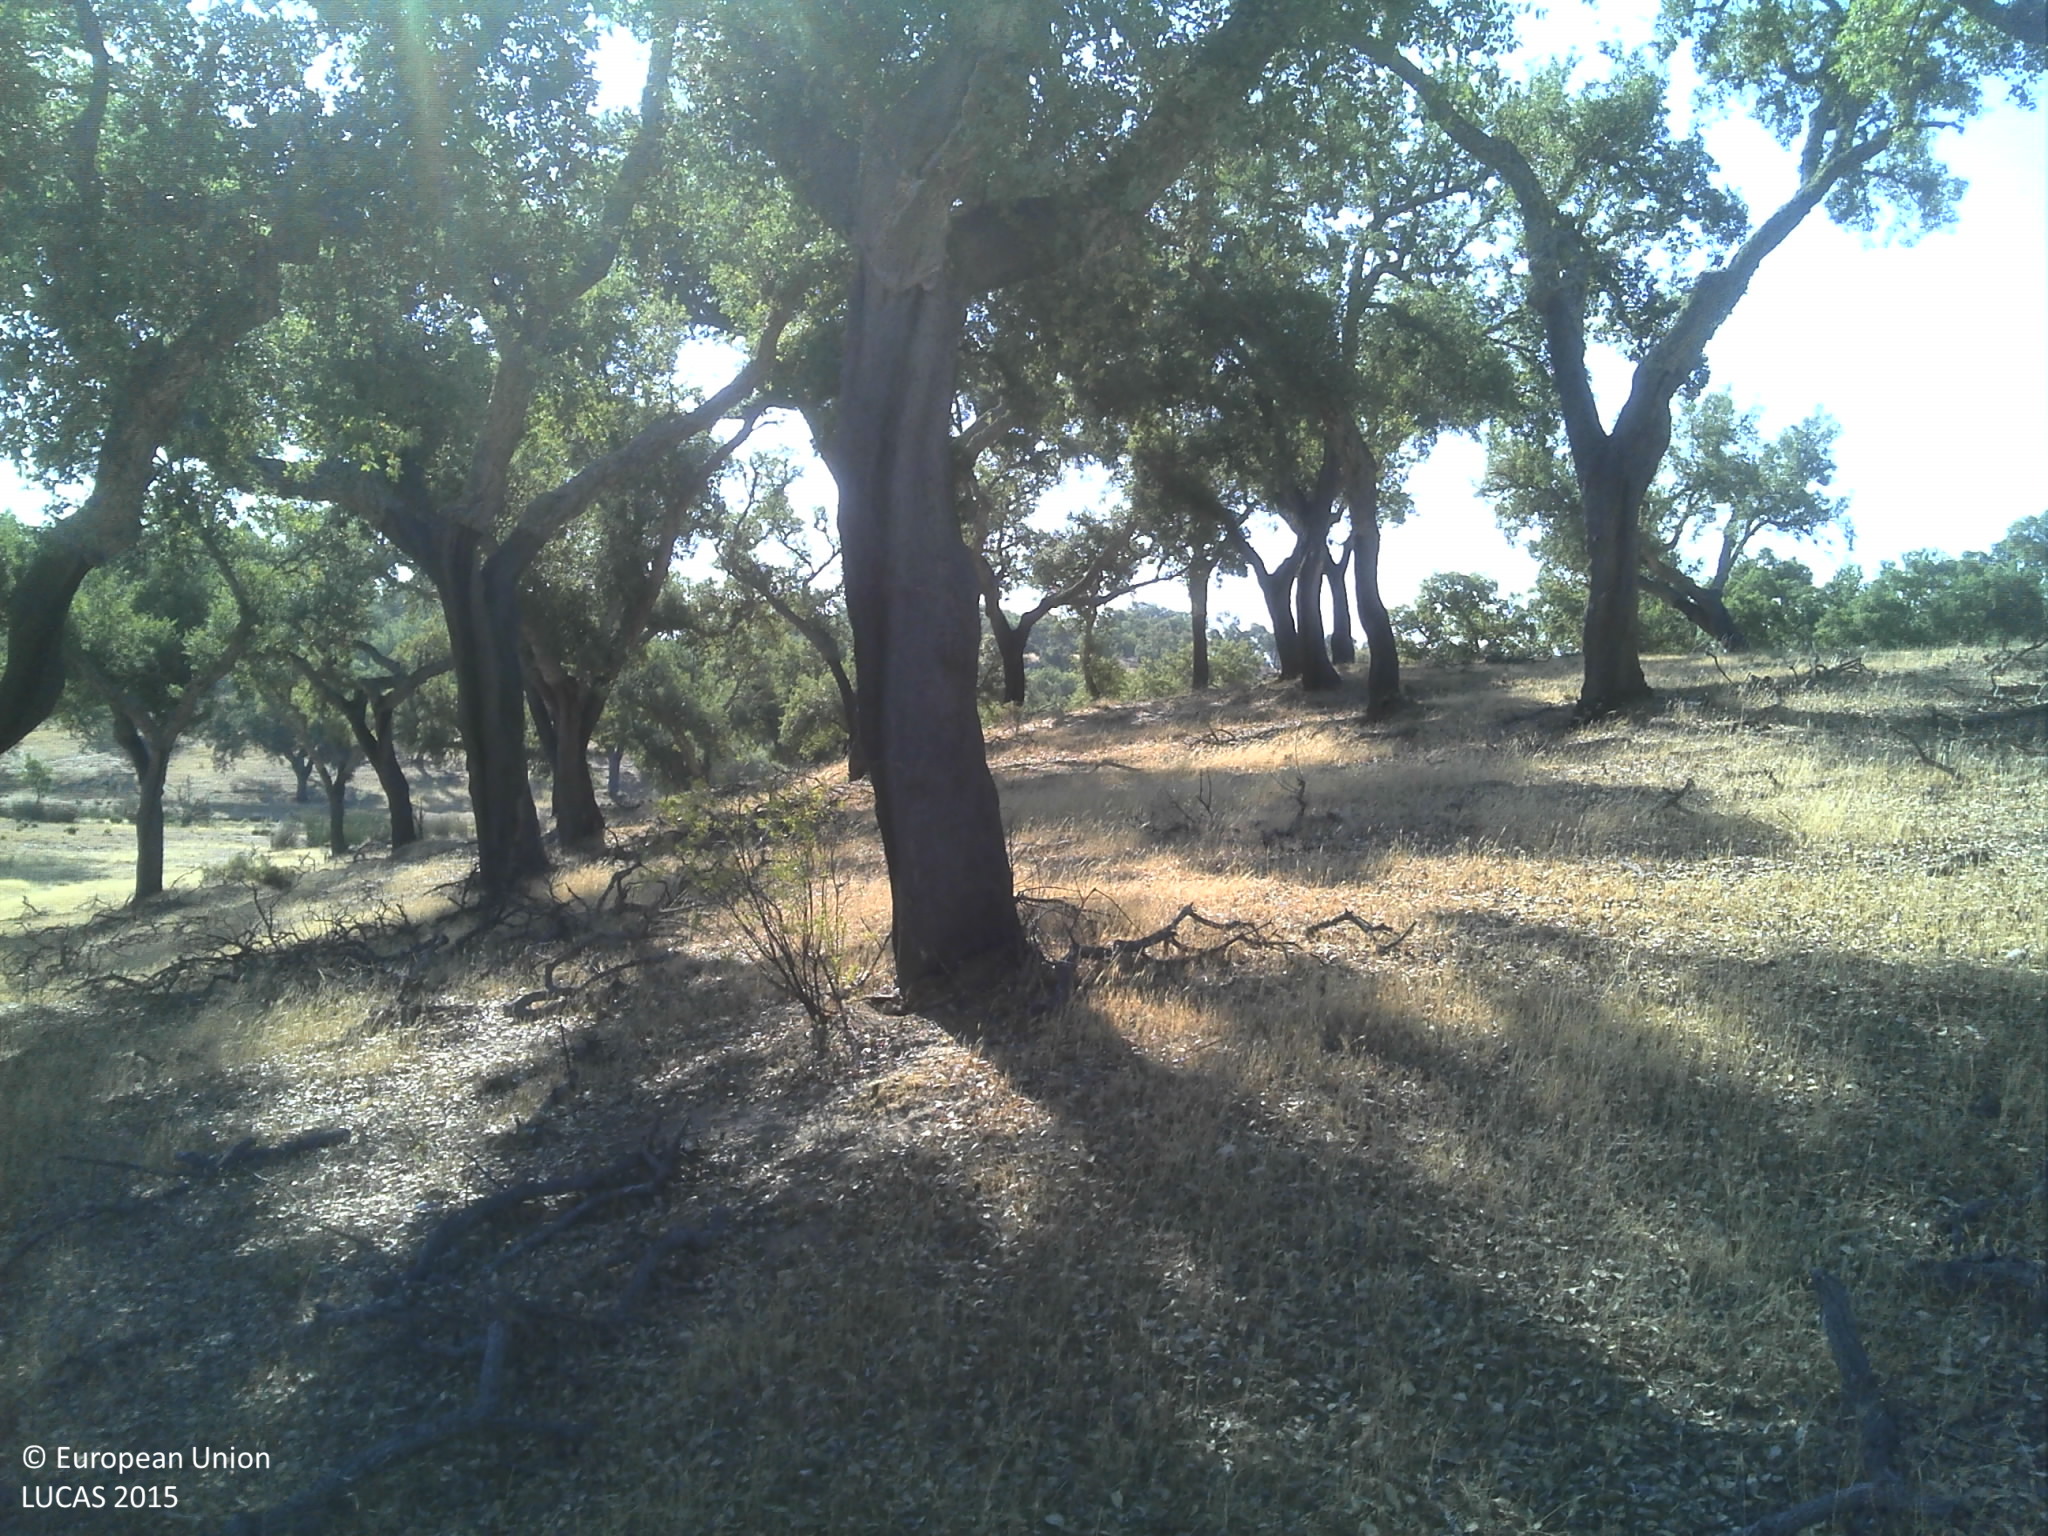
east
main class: Woodland
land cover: Broadleaved woodland
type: broadleaved evergreen forest
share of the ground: 50 - 75 %
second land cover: Grassland without tree/shrub cover
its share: 25 - 50 %
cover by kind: broadleaved forest trees 50 %, herbaceous plants 40 %, unconsolidated bare surface 10 %
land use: Forestry
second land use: Agriculture (excluding fallow land and kitchen gardens)
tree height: > 5 m
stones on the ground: 10 - 25 %
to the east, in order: Broadleaved woodland; Grassland without tree/shrub cover; Broadleaved woodland; Shruby margins; Rivers and streams; Shruby margins; Broadleaved woodland
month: June
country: PT
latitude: 39.7967
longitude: -7.2487
